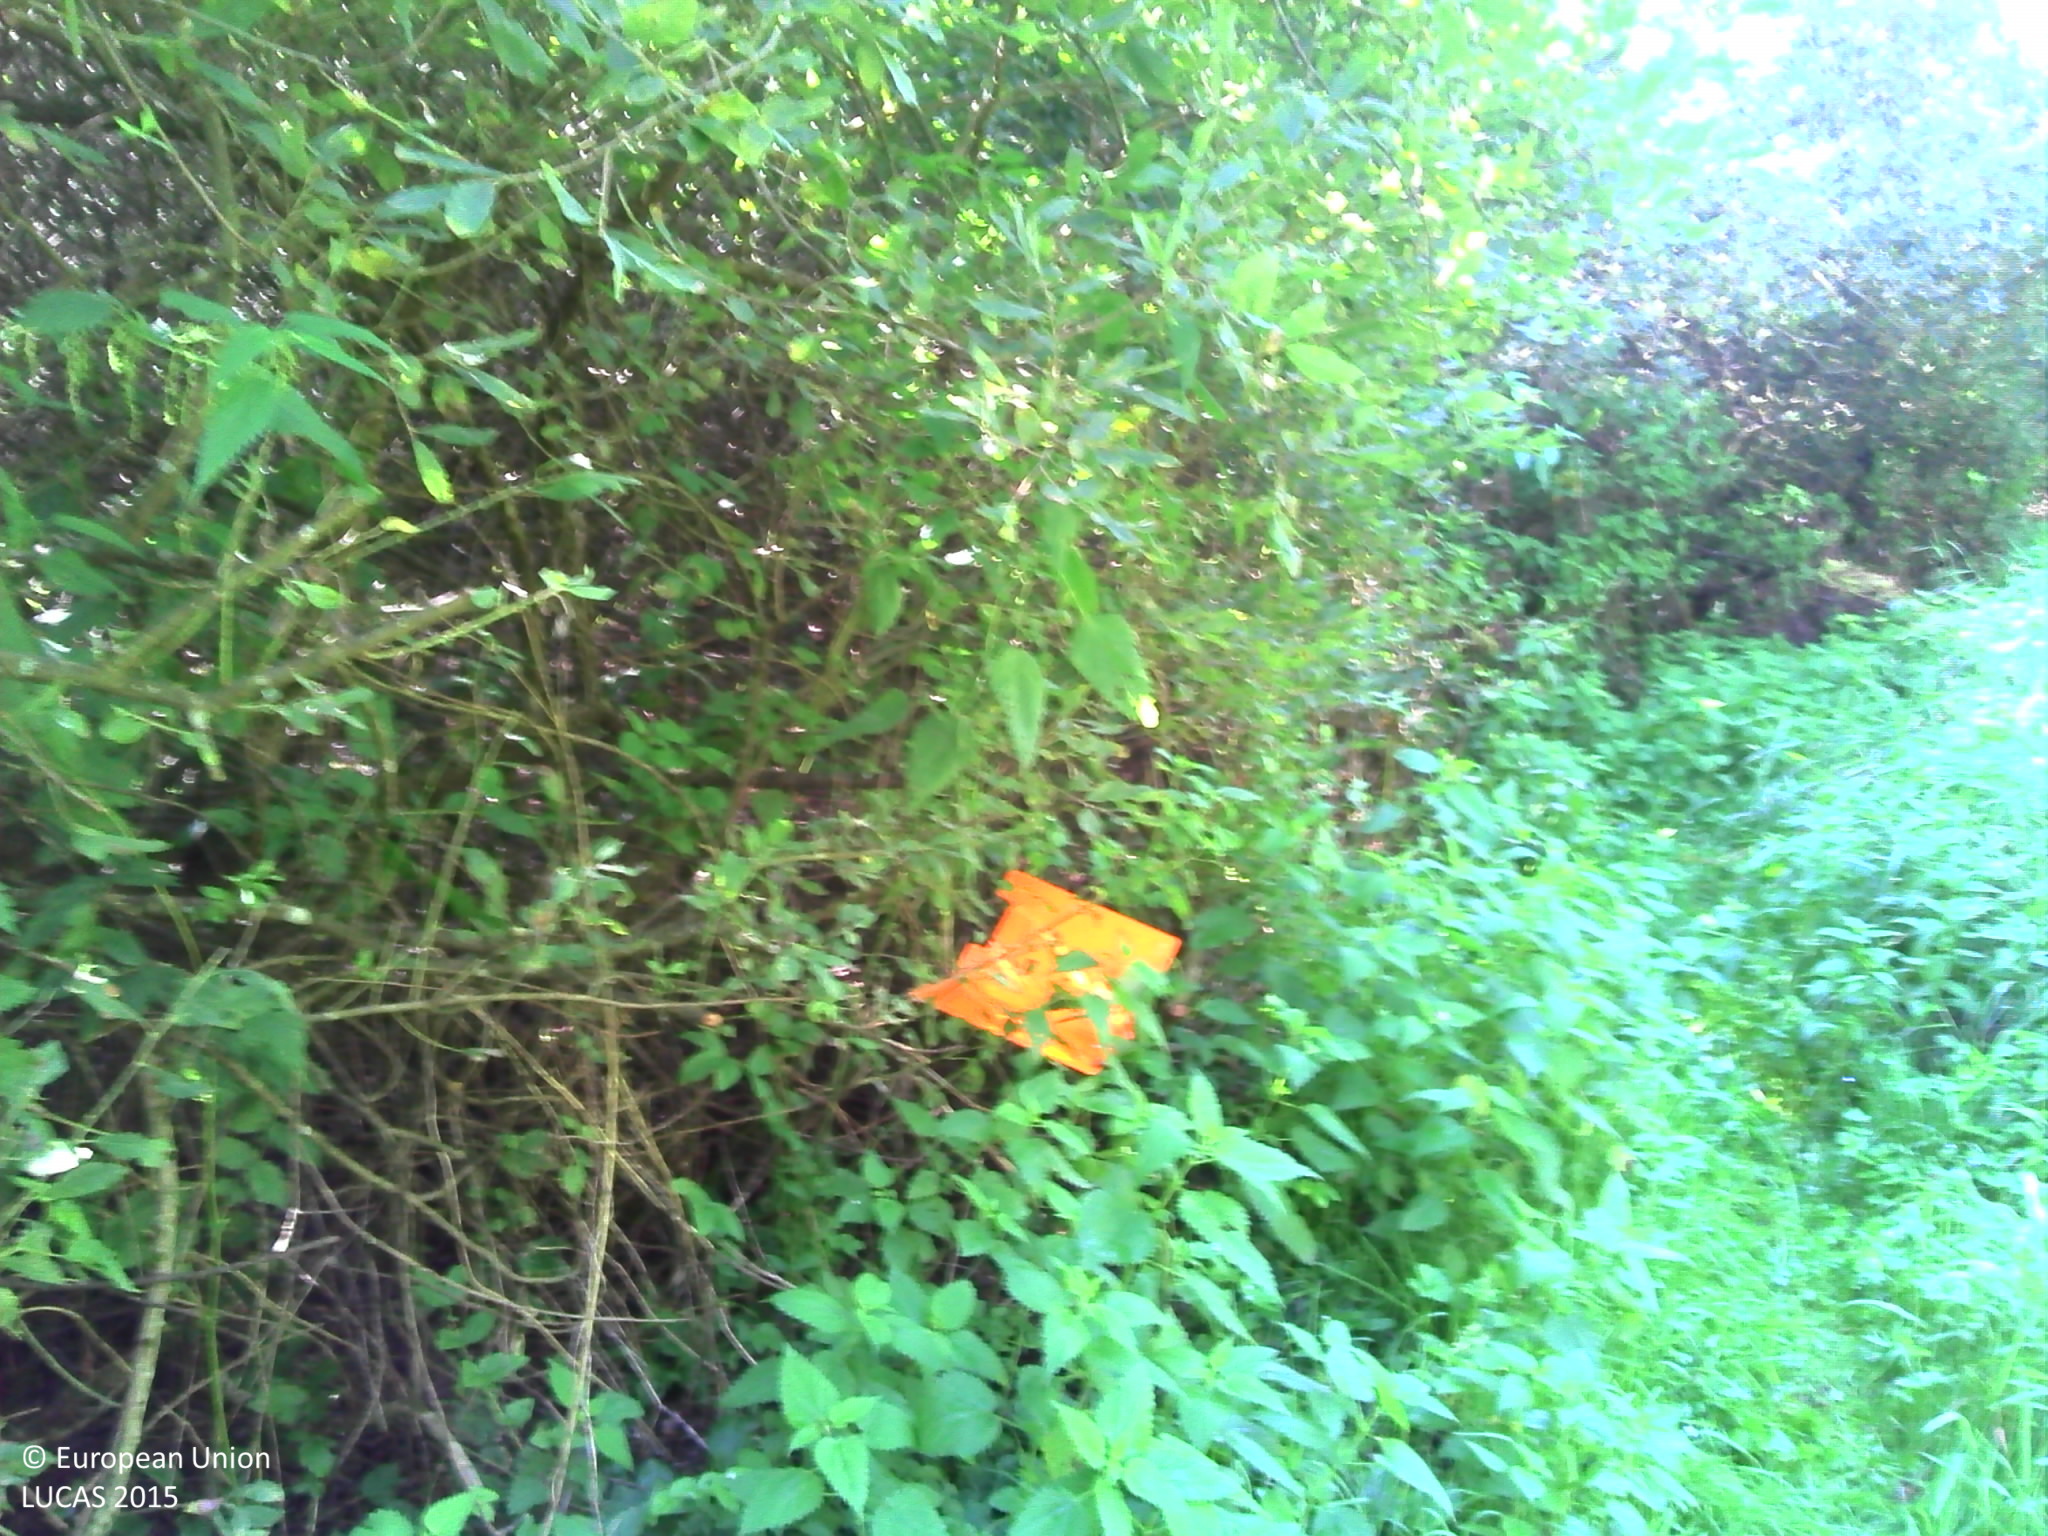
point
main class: Woodland
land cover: Broadleaved woodland
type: floodplain forest
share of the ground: > 75 %
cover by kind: broadleaved forest trees 60 %, shrubs 30 %, herbaceous plants 10 %
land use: Semi-natural and natural areas not in use
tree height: > 5 m
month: September
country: FR
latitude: 47.2764
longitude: 6.2343
